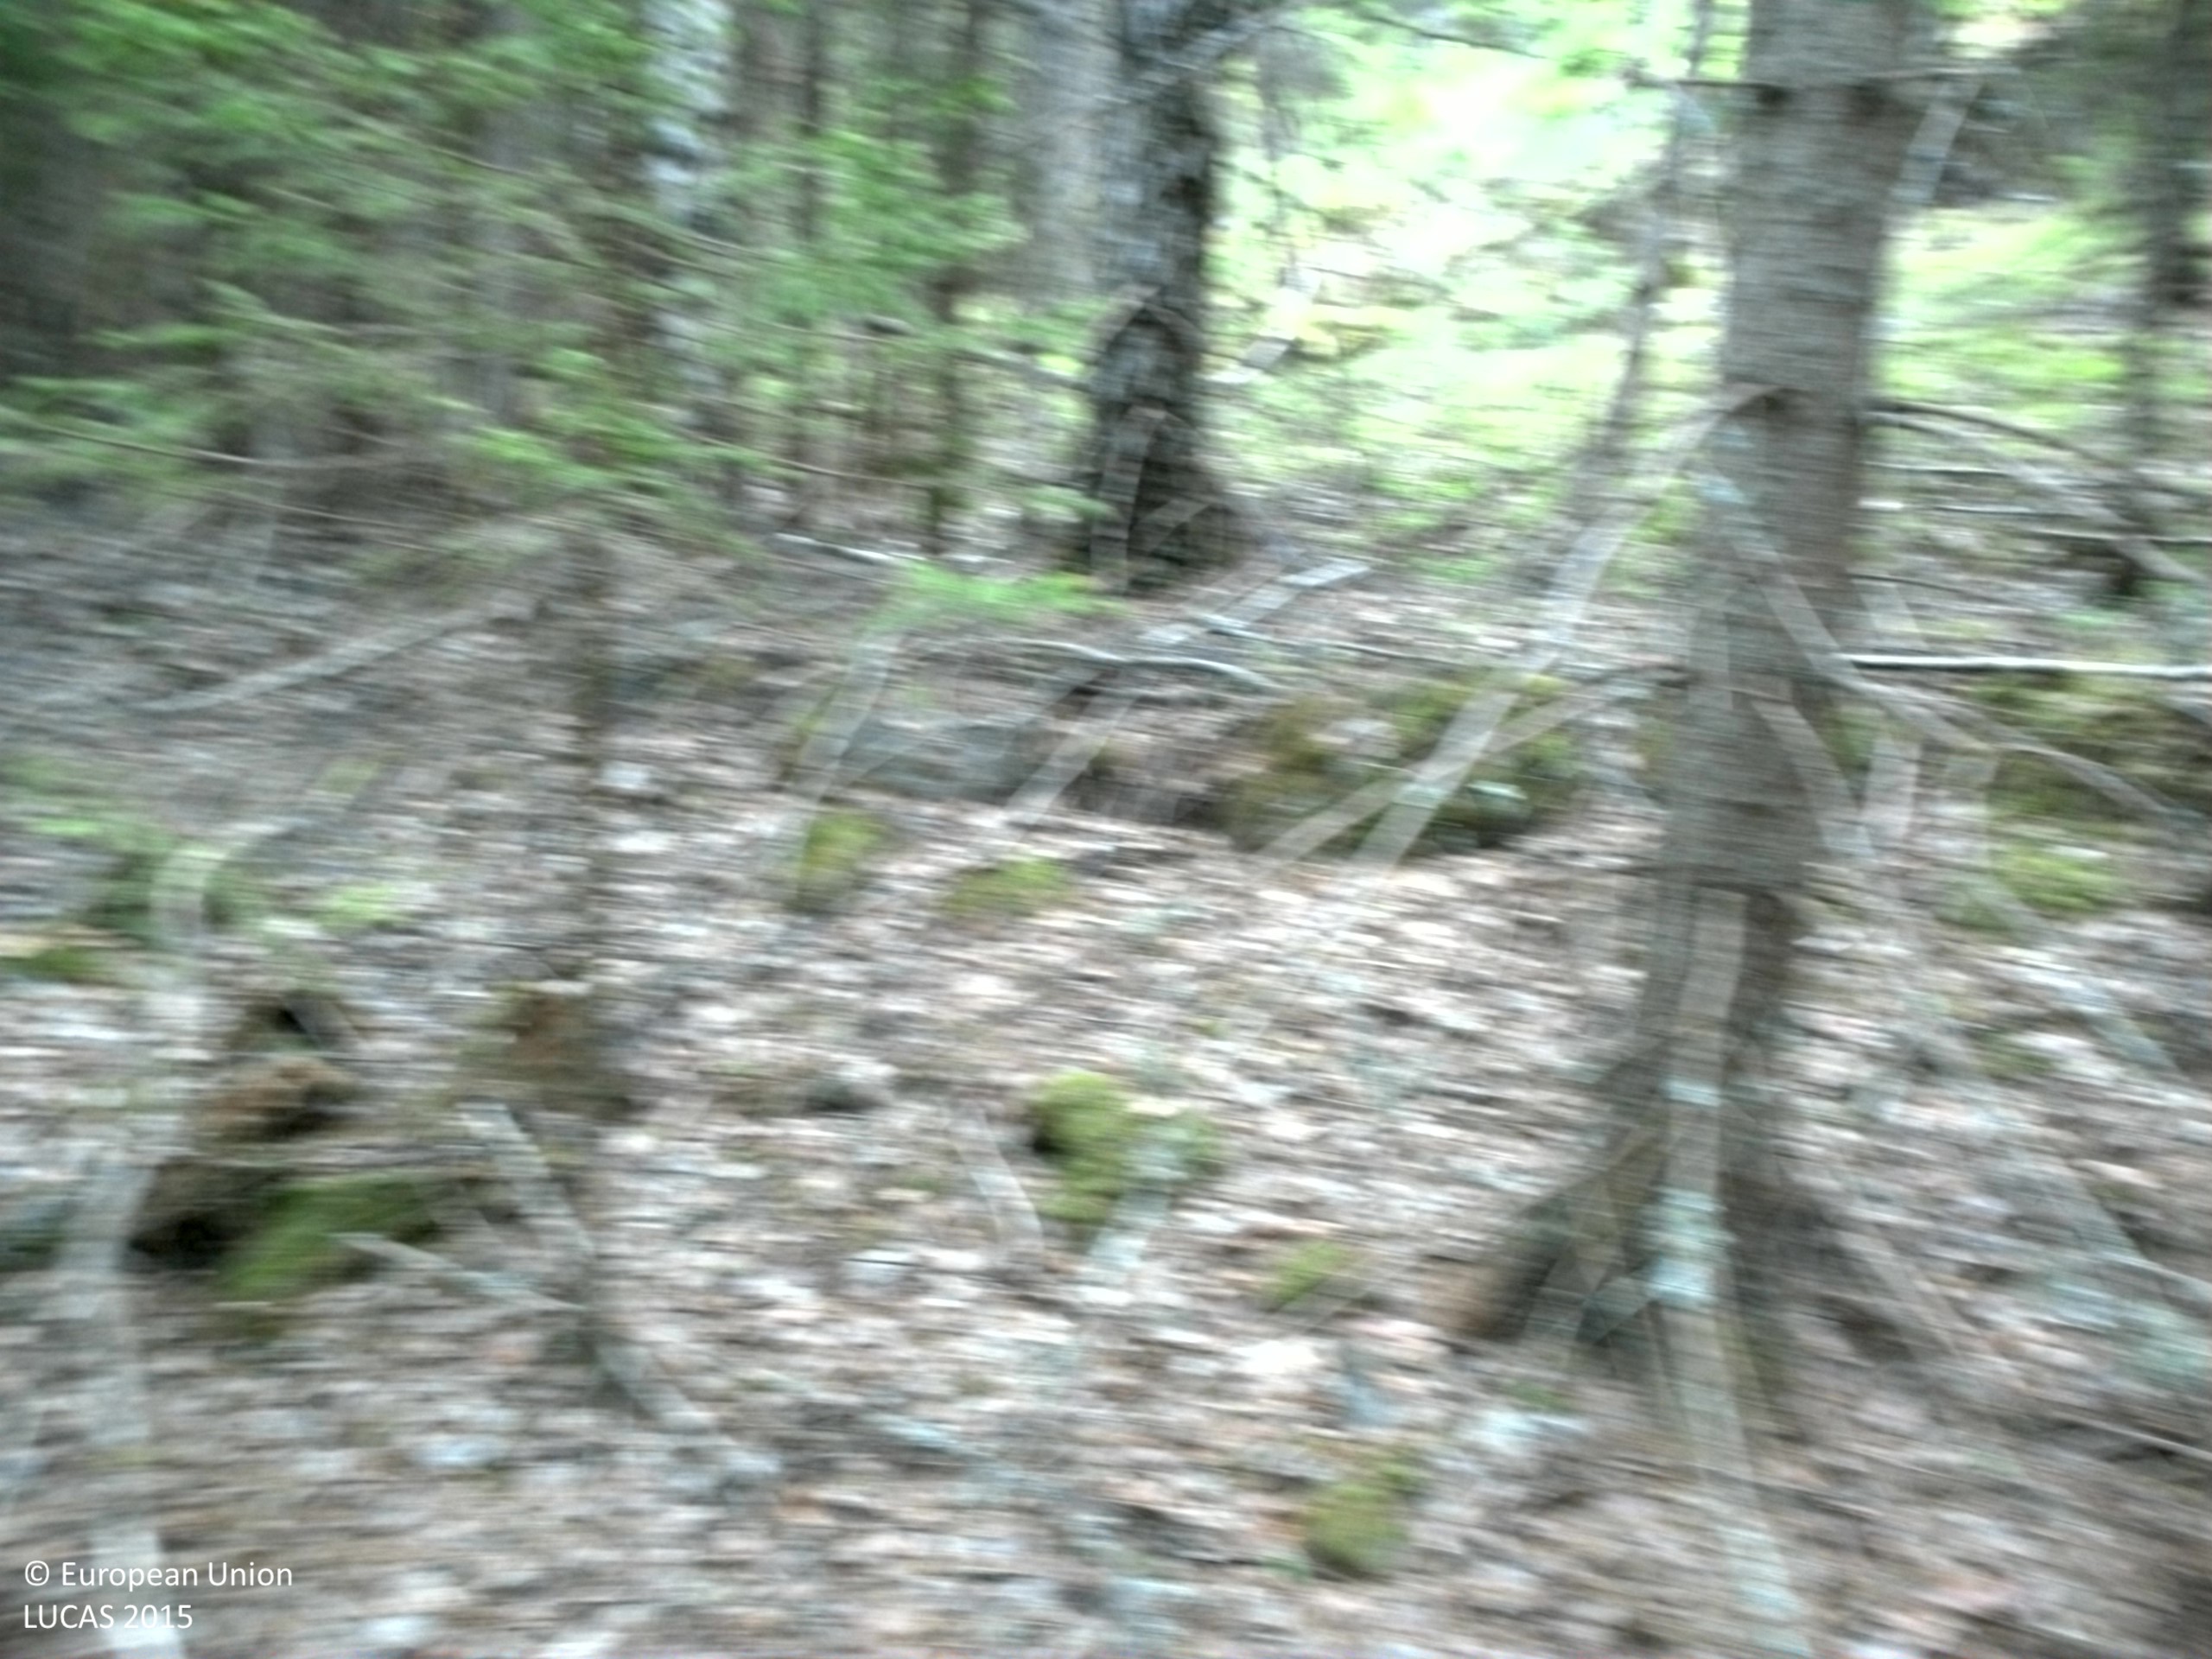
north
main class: Woodland
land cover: Spruce dominated coniferous woodland
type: boreal forest
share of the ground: > 75 %
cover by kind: coniferous forest trees 80 %, herbaceous plants 10 %, broadleaved forest trees 5 %, unconsolidated bare surface 5 %
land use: Forestry
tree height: > 5 m
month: June
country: SE
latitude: 62.9519
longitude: 17.8428
